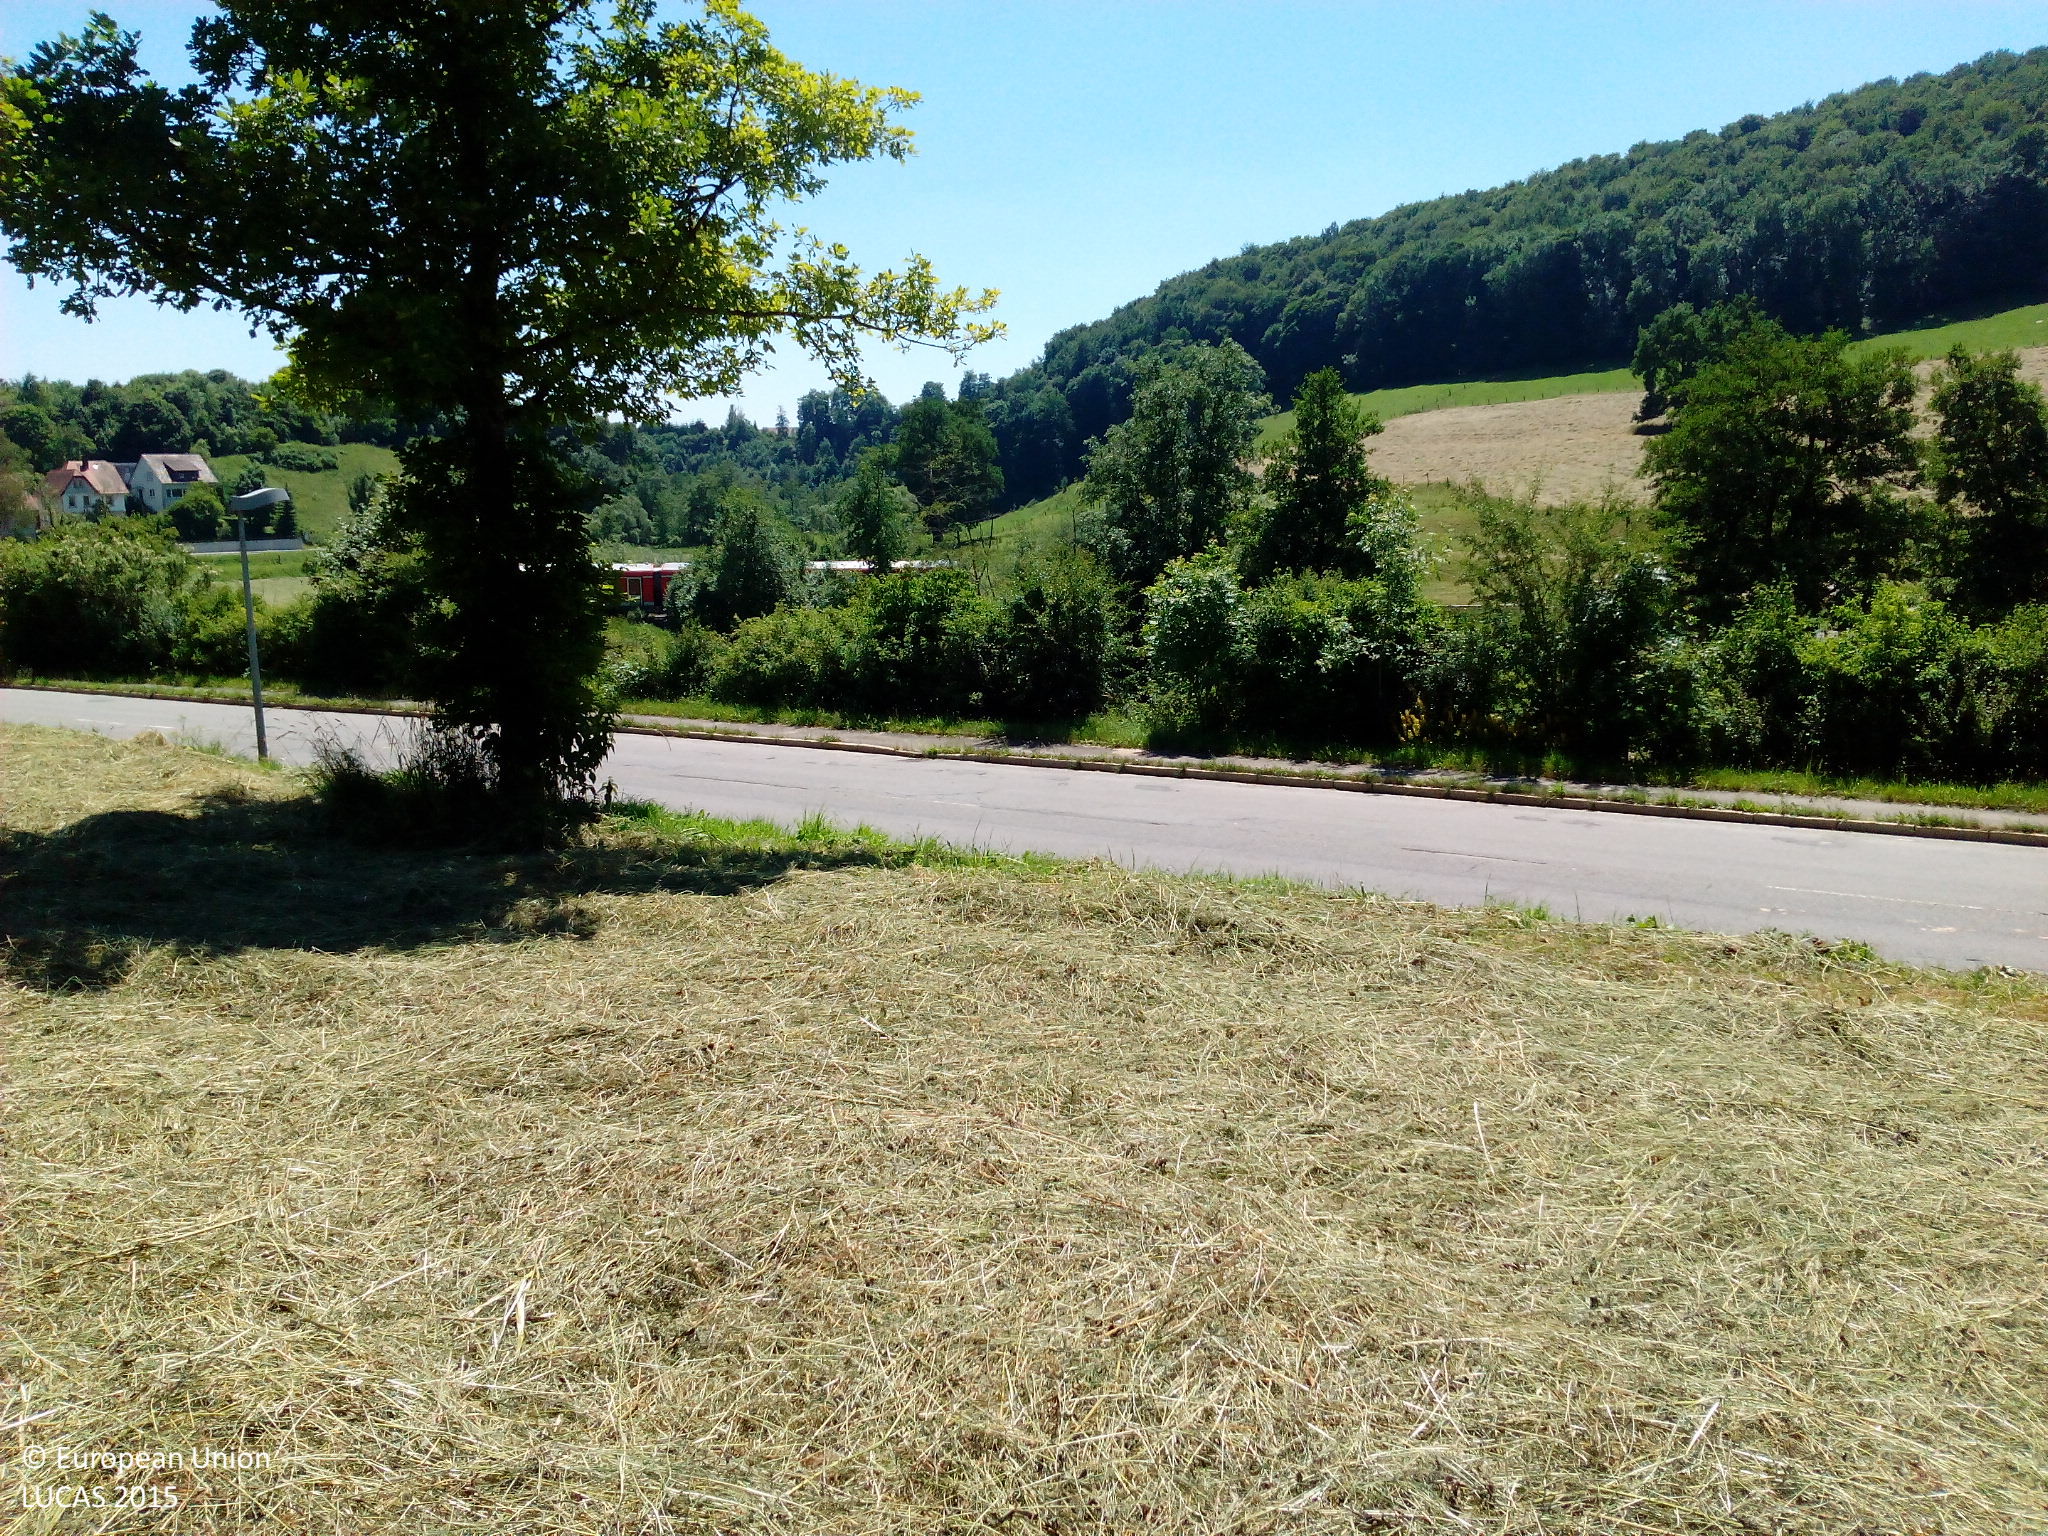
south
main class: Grassland
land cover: Grassland without tree/shrub cover
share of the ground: > 75 %
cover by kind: herbaceous plants 100 %
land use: Agriculture (excluding fallow land and kitchen gardens)
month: July
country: DE
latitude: 48.3840
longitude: 9.4197
